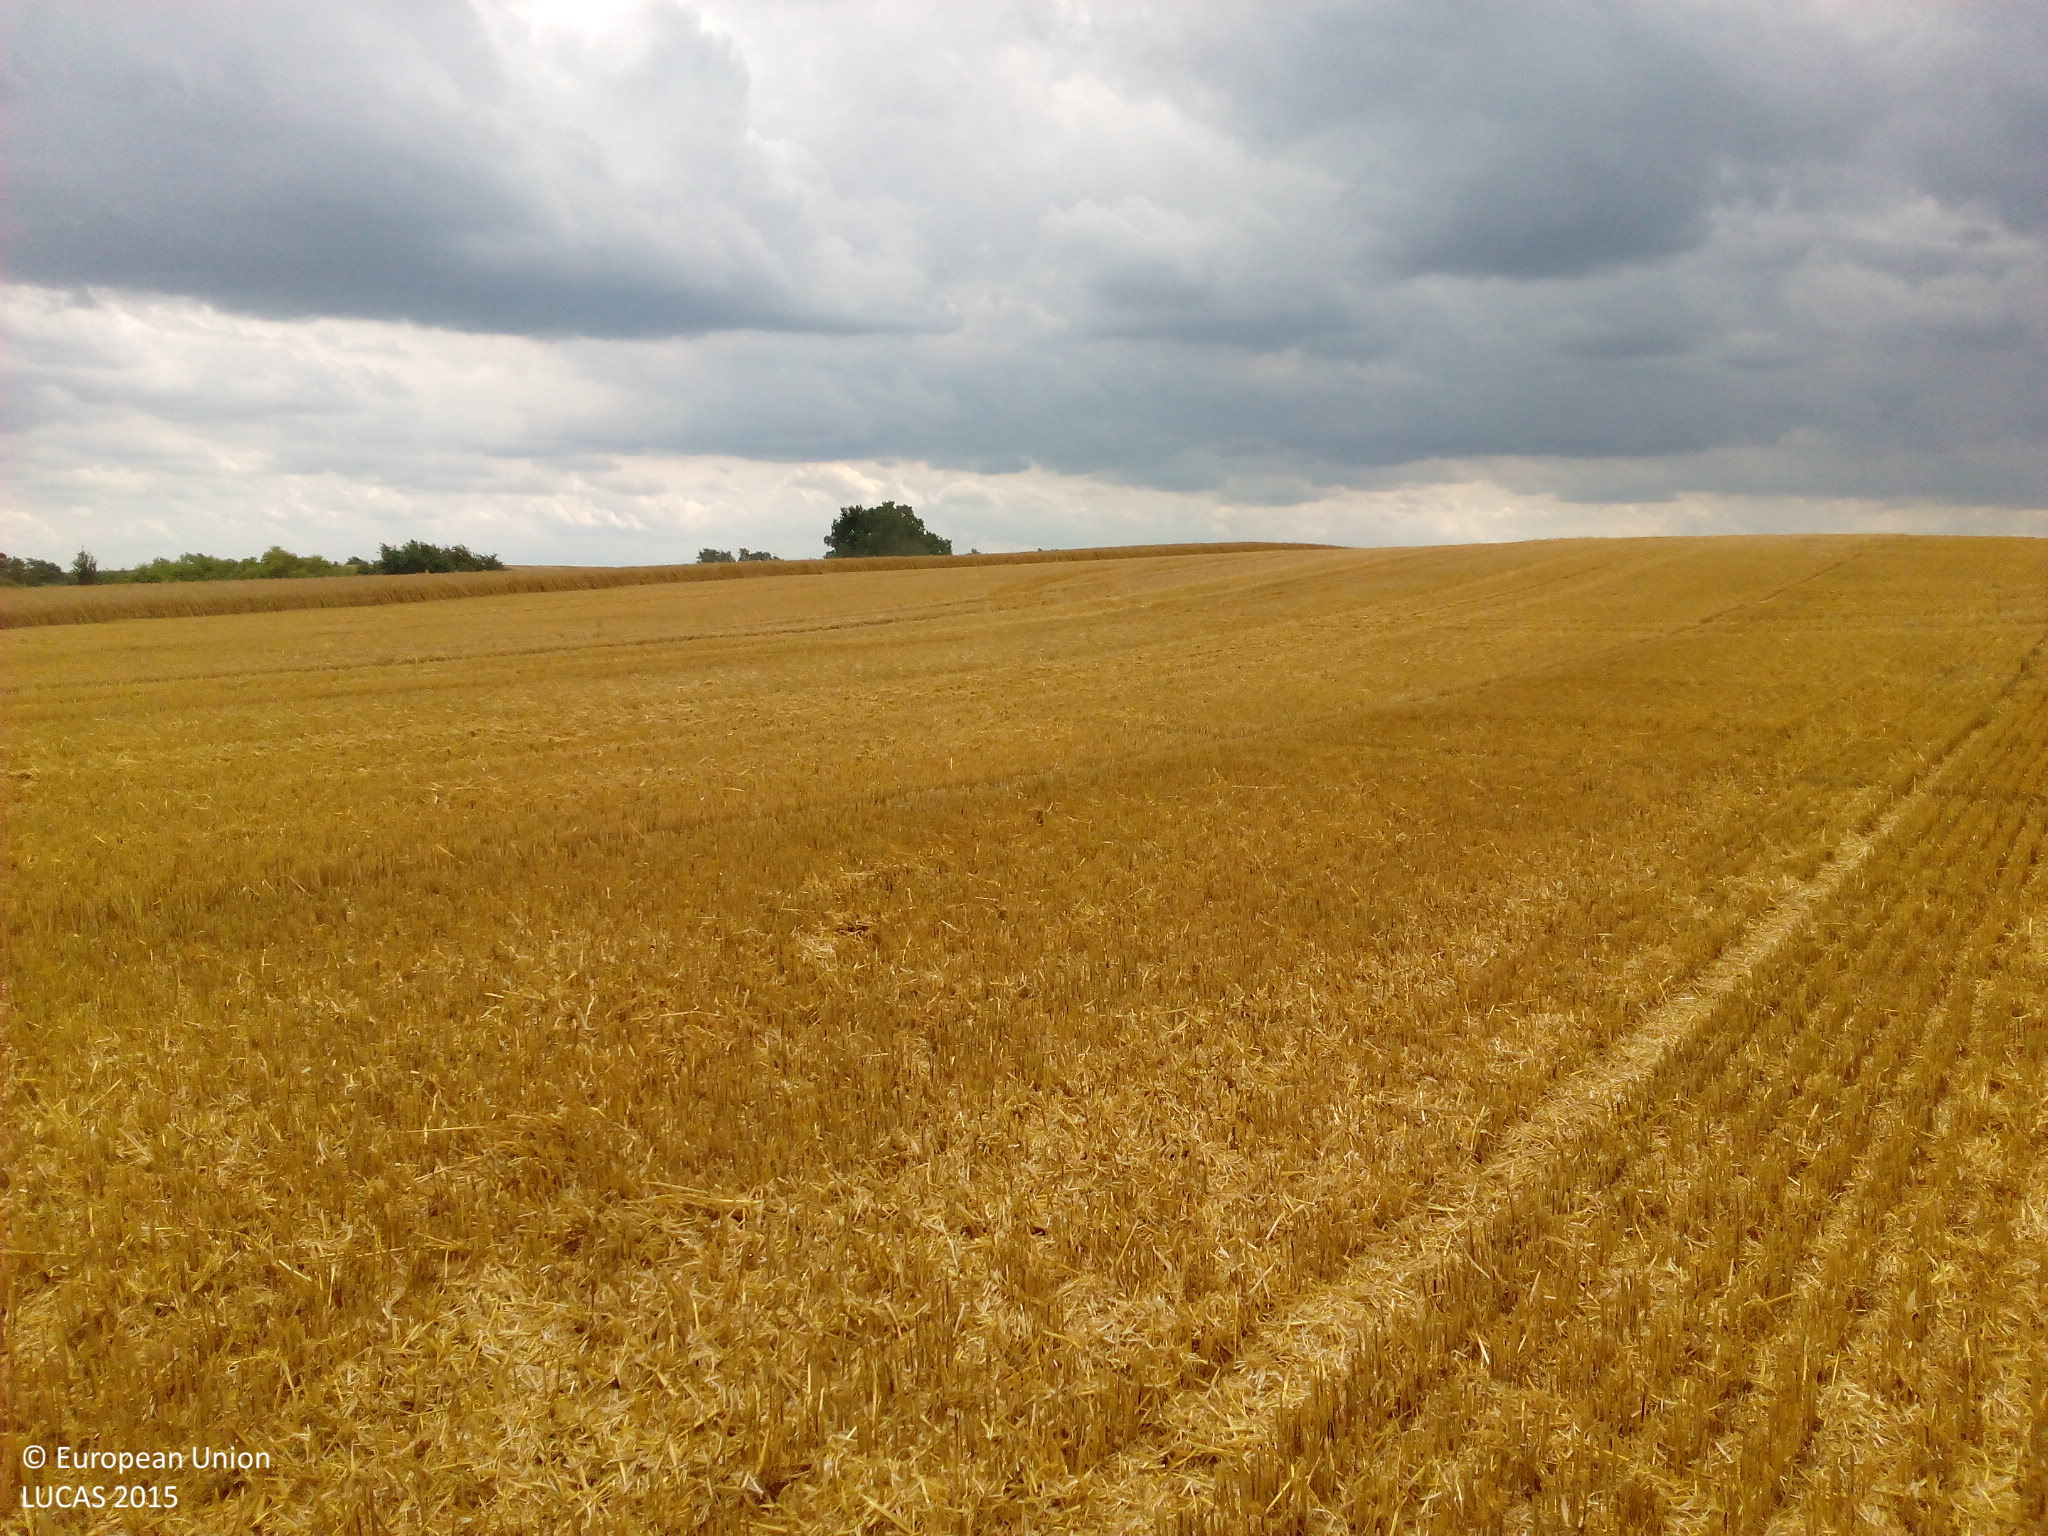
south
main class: Cropland
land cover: Barley
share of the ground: < 10 %
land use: Agriculture (excluding fallow land and kitchen gardens)
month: July
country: DE
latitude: 53.5435
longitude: 13.6972
